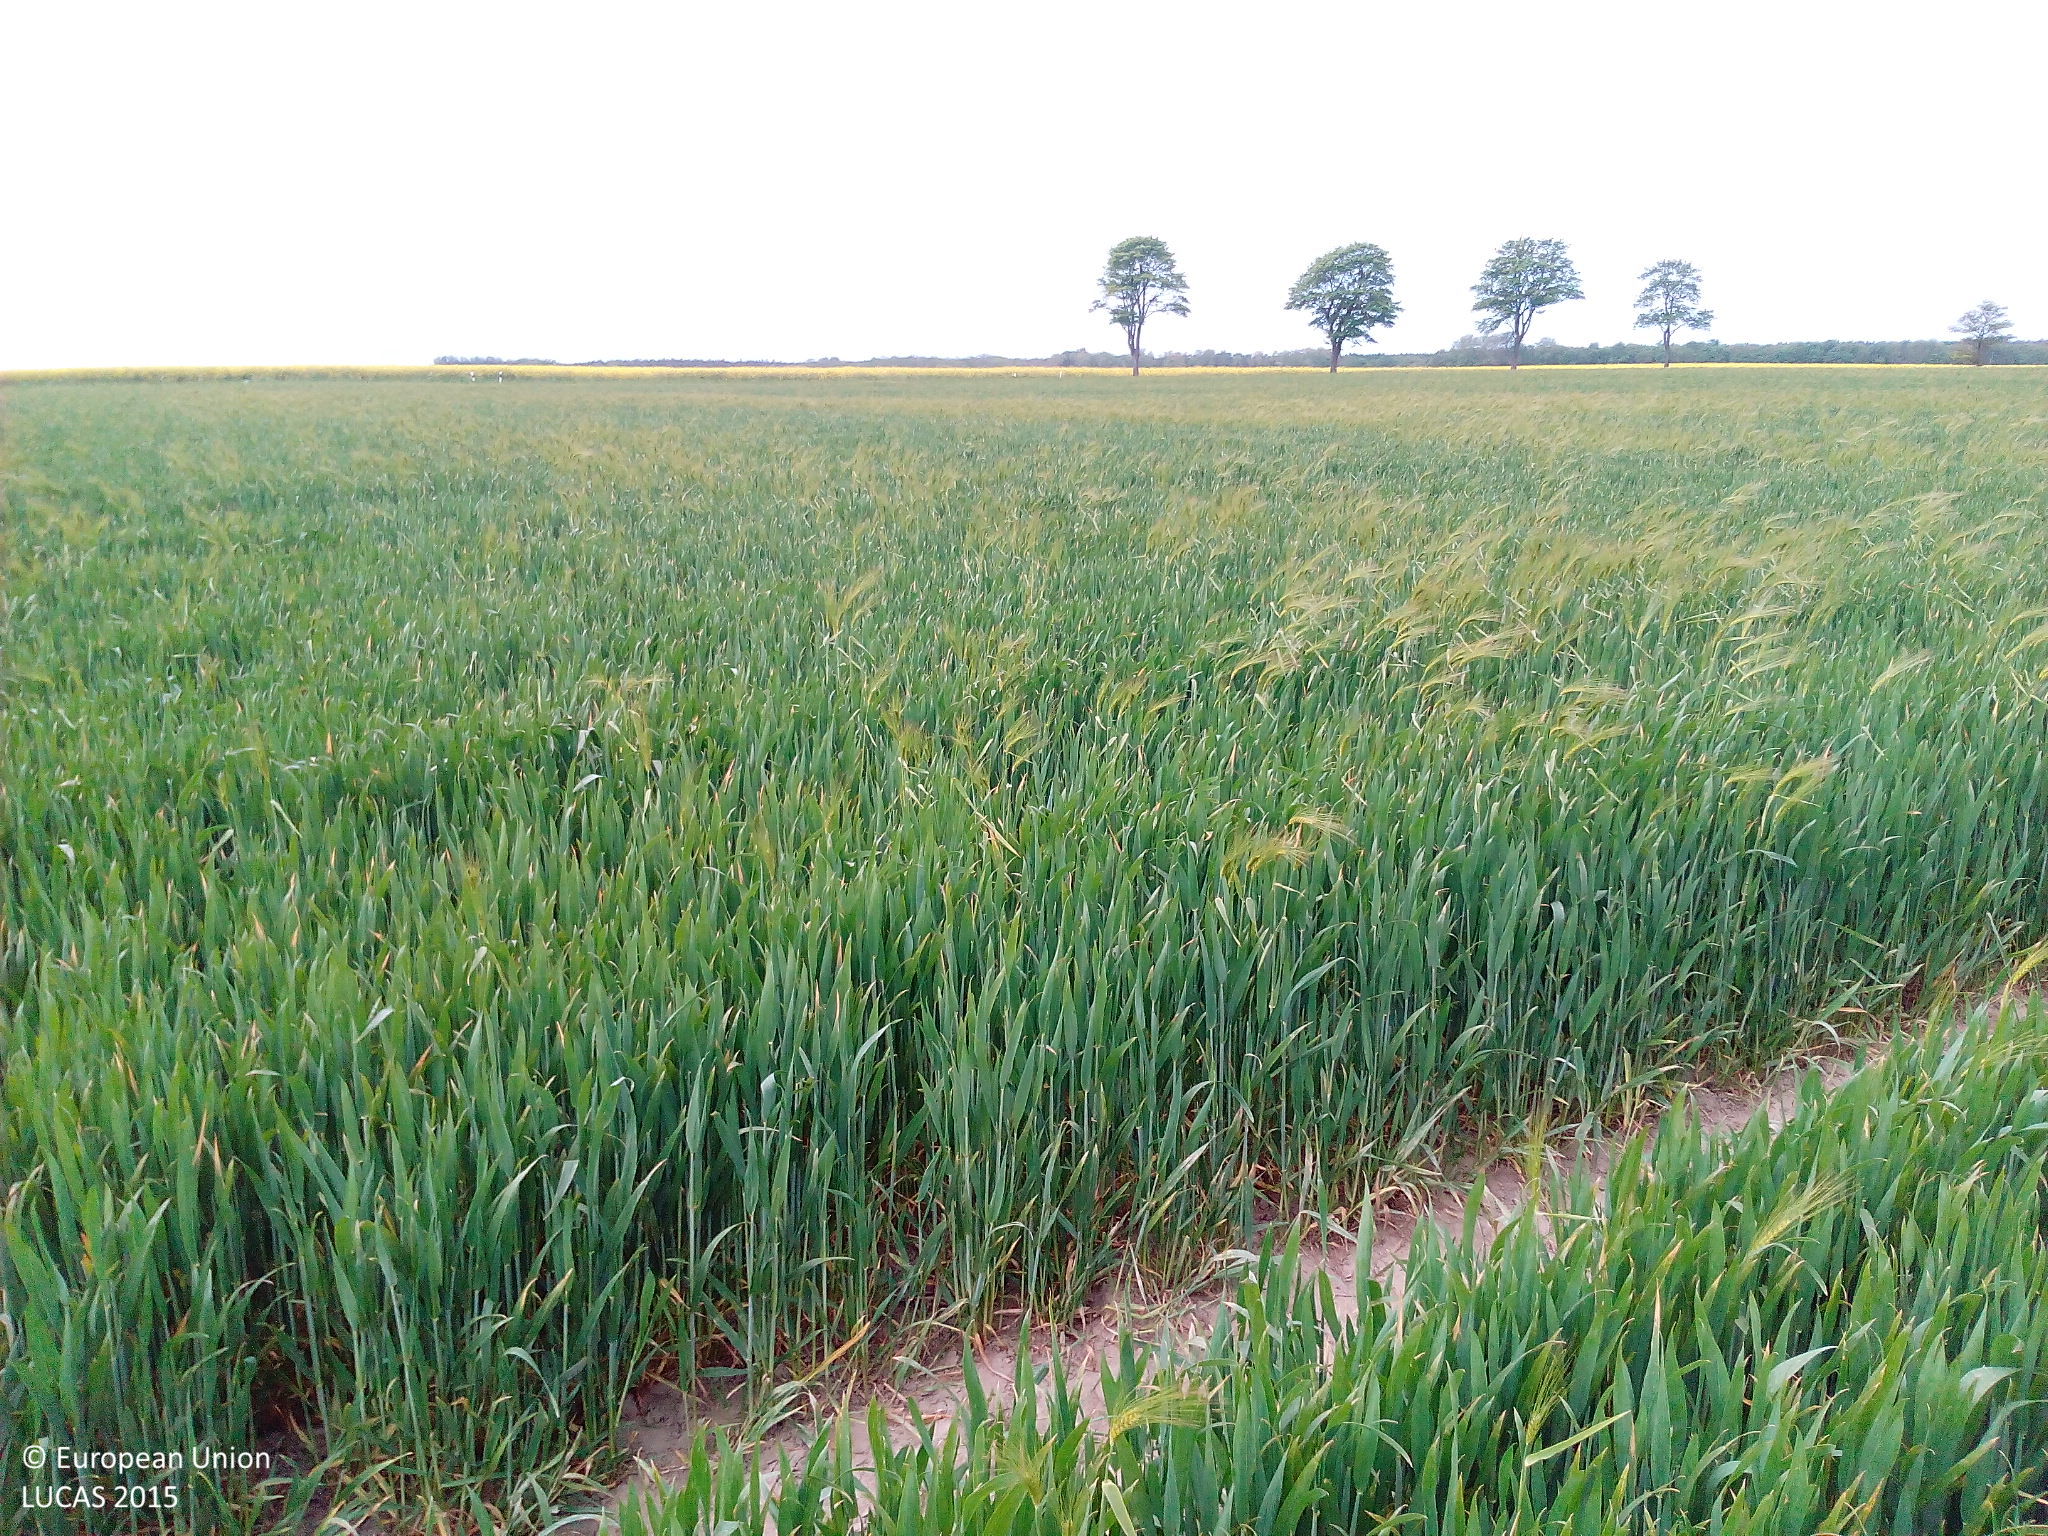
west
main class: Cropland
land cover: Mixed cereals for fodder
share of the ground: > 75 %
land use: Agriculture (excluding fallow land and kitchen gardens)
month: May
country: DE
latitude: 54.4906
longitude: 13.2873
